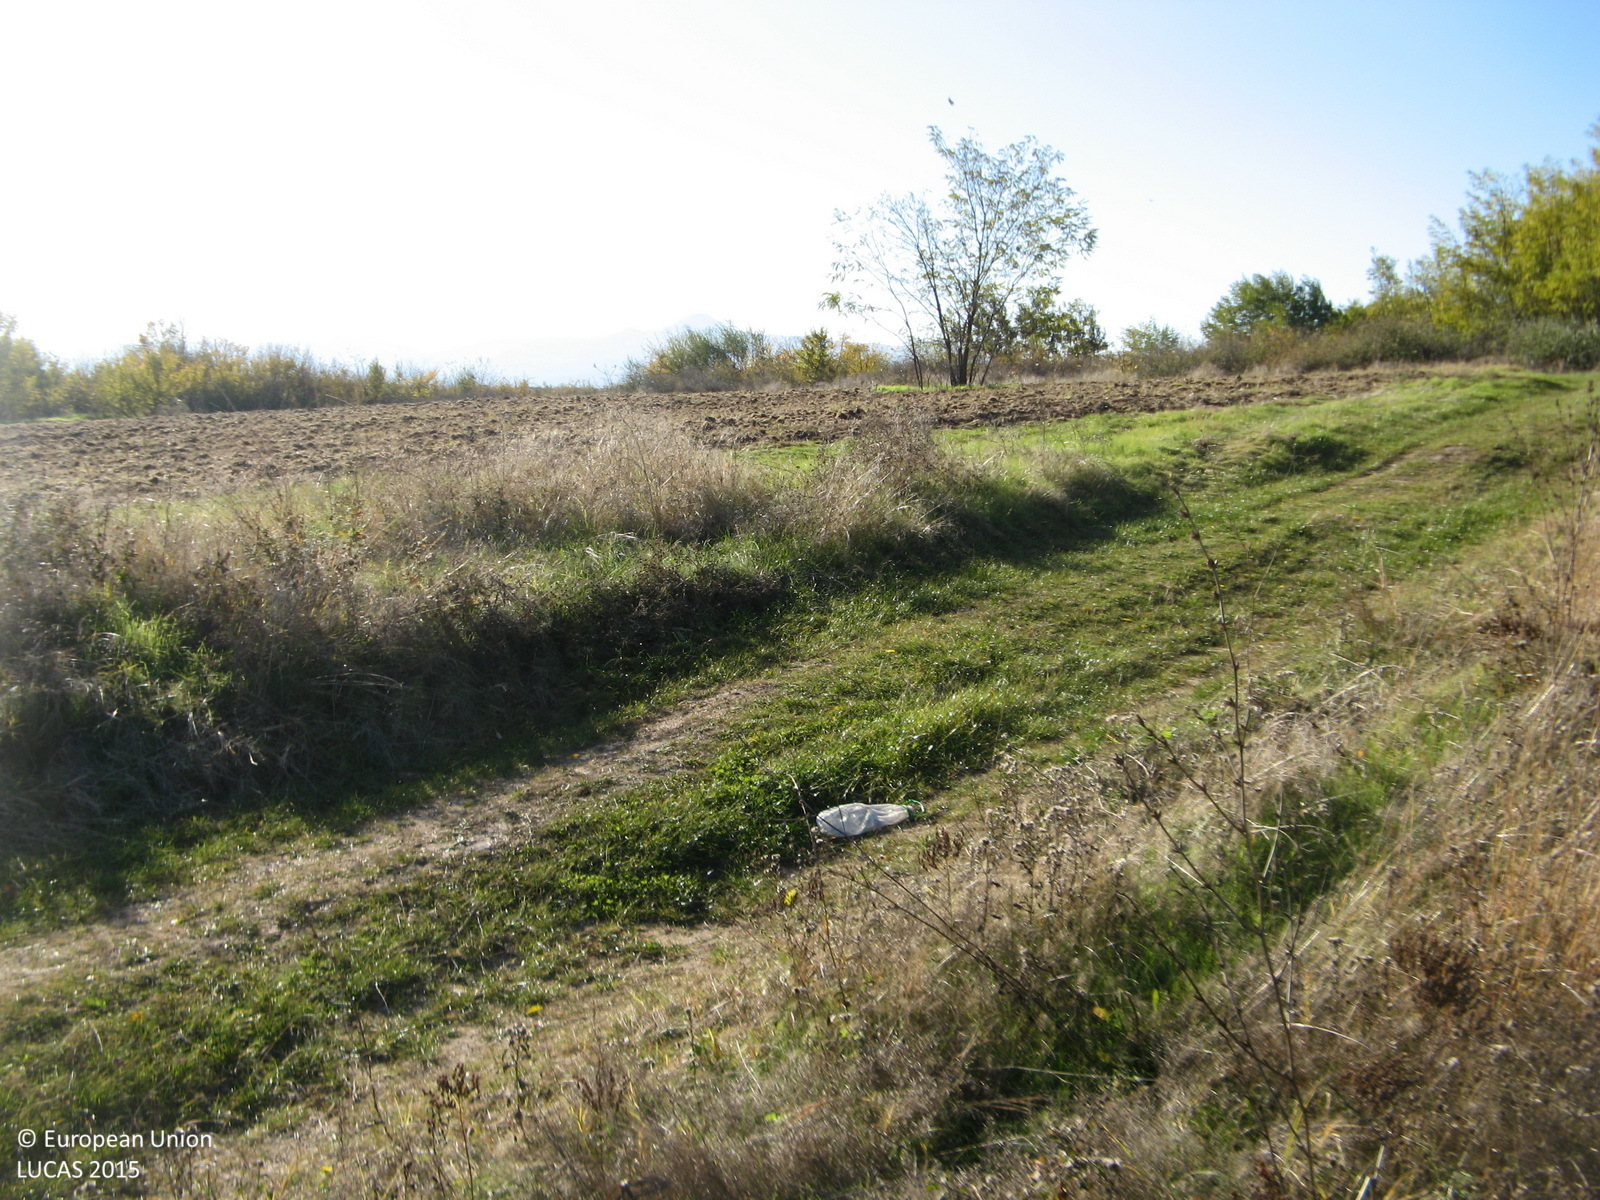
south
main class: Shrubland
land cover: Shrubland with sparse tree cover
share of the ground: > 75 %
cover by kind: shrubs 70 %, herbaceous plants 20 %, broadleaved forest trees 5 %, unconsolidated bare surface 5 %
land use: Semi-natural and natural areas not in use
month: November
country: BG
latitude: 42.0498
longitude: 25.1977
